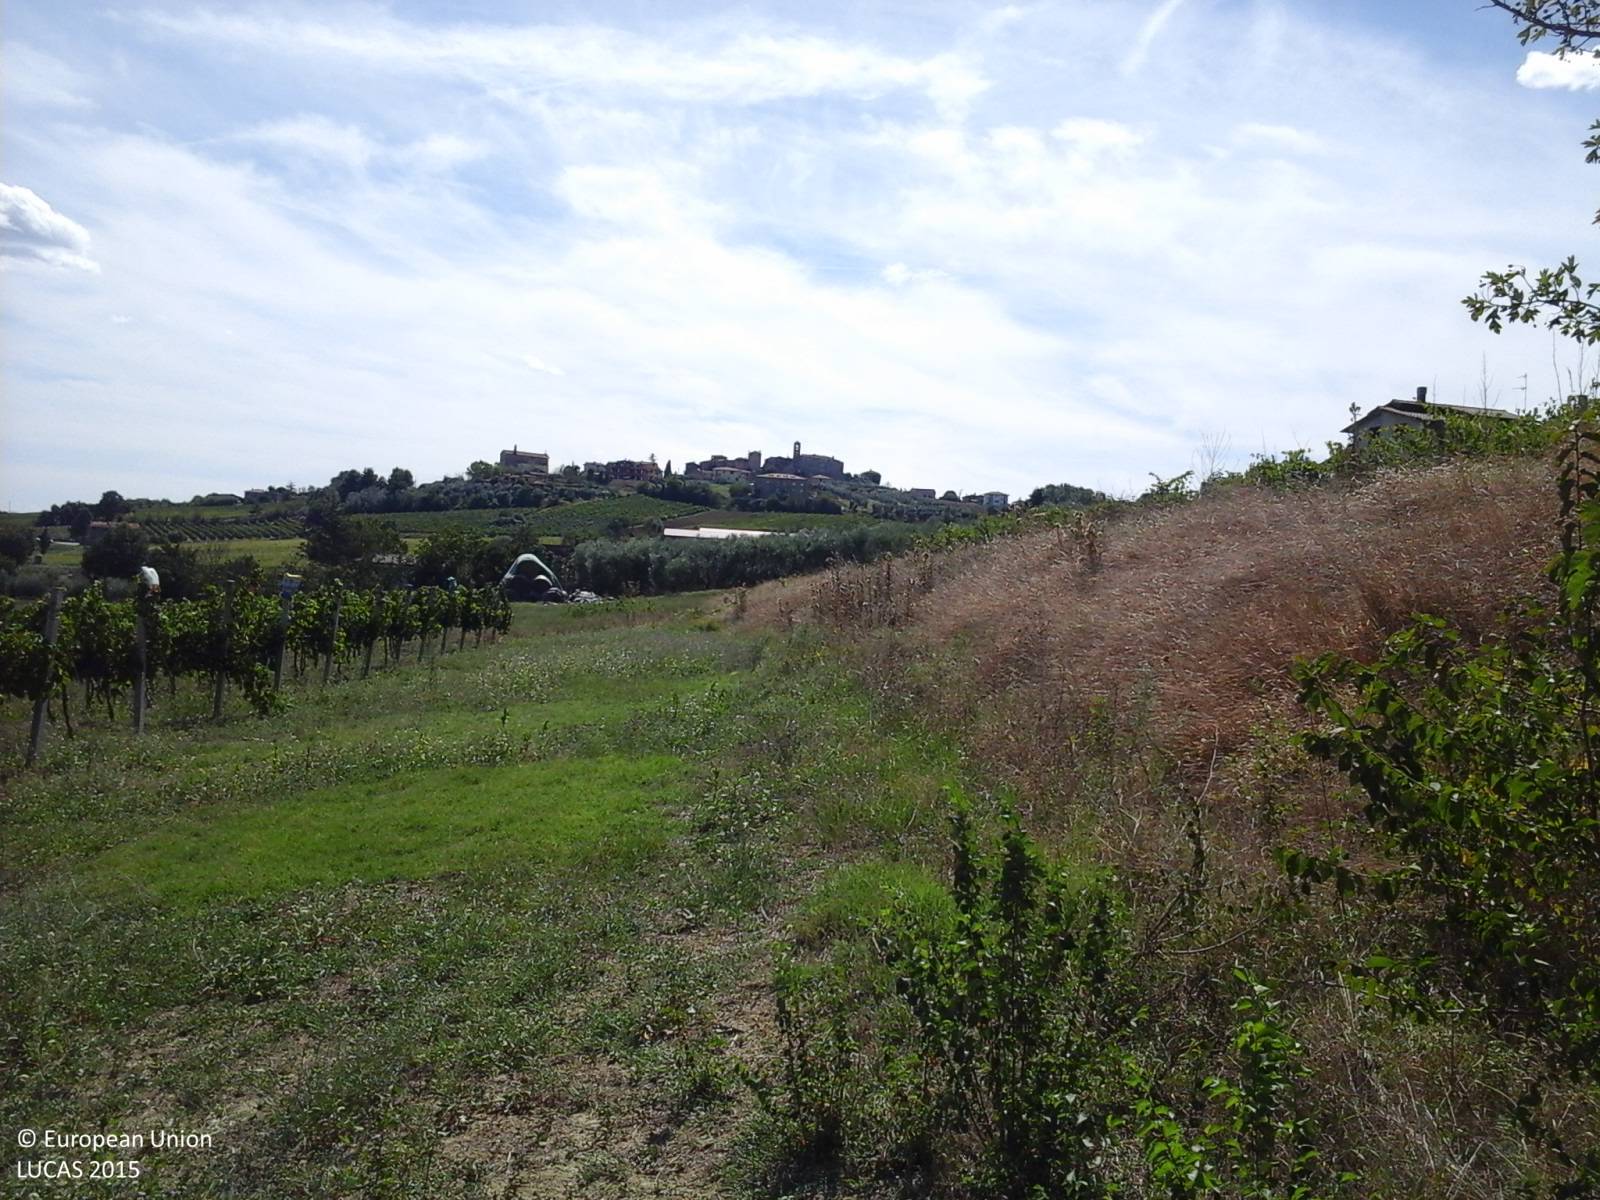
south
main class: Grassland
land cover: Grassland without tree/shrub cover
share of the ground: 25 - 50 %
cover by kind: herbaceous plants 100 %
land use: Agriculture (excluding fallow land and kitchen gardens)
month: September
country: IT
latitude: 42.9878
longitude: 12.3600
